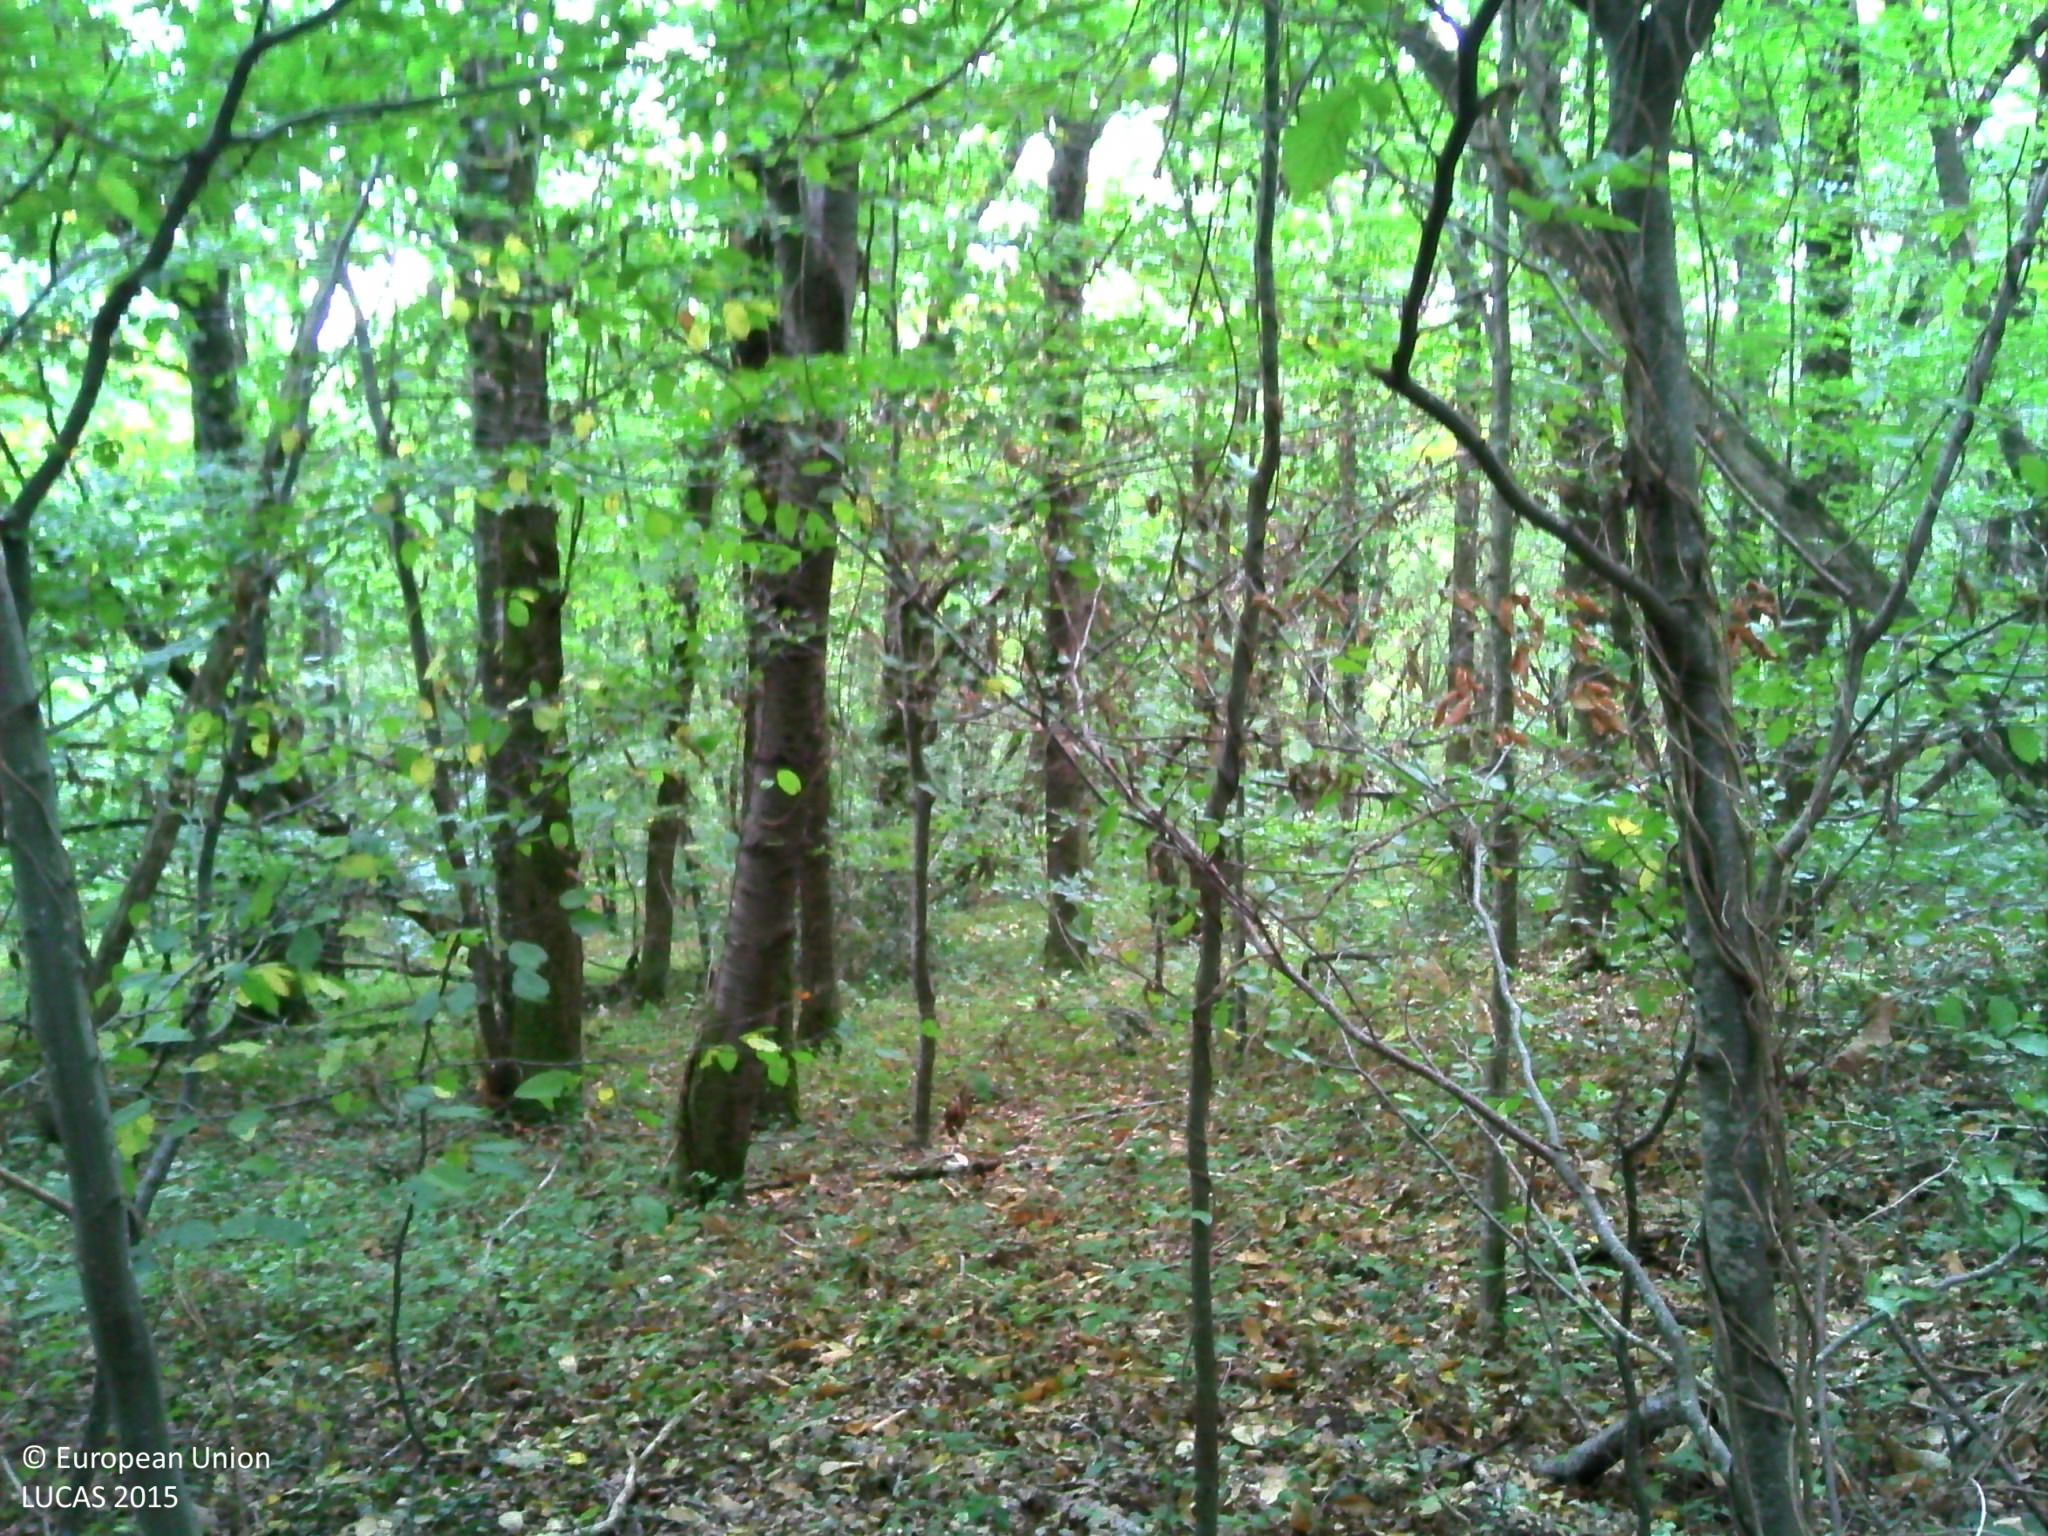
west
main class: Woodland
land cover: Broadleaved woodland
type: mesophytic deciduous forest
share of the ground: > 75 %
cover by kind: broadleaved forest trees 85 %, unconsolidated bare surface 10 %, herbaceous plants 5 %
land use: Forestry
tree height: > 5 m
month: September
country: FR
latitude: 46.4206
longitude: 1.6245
